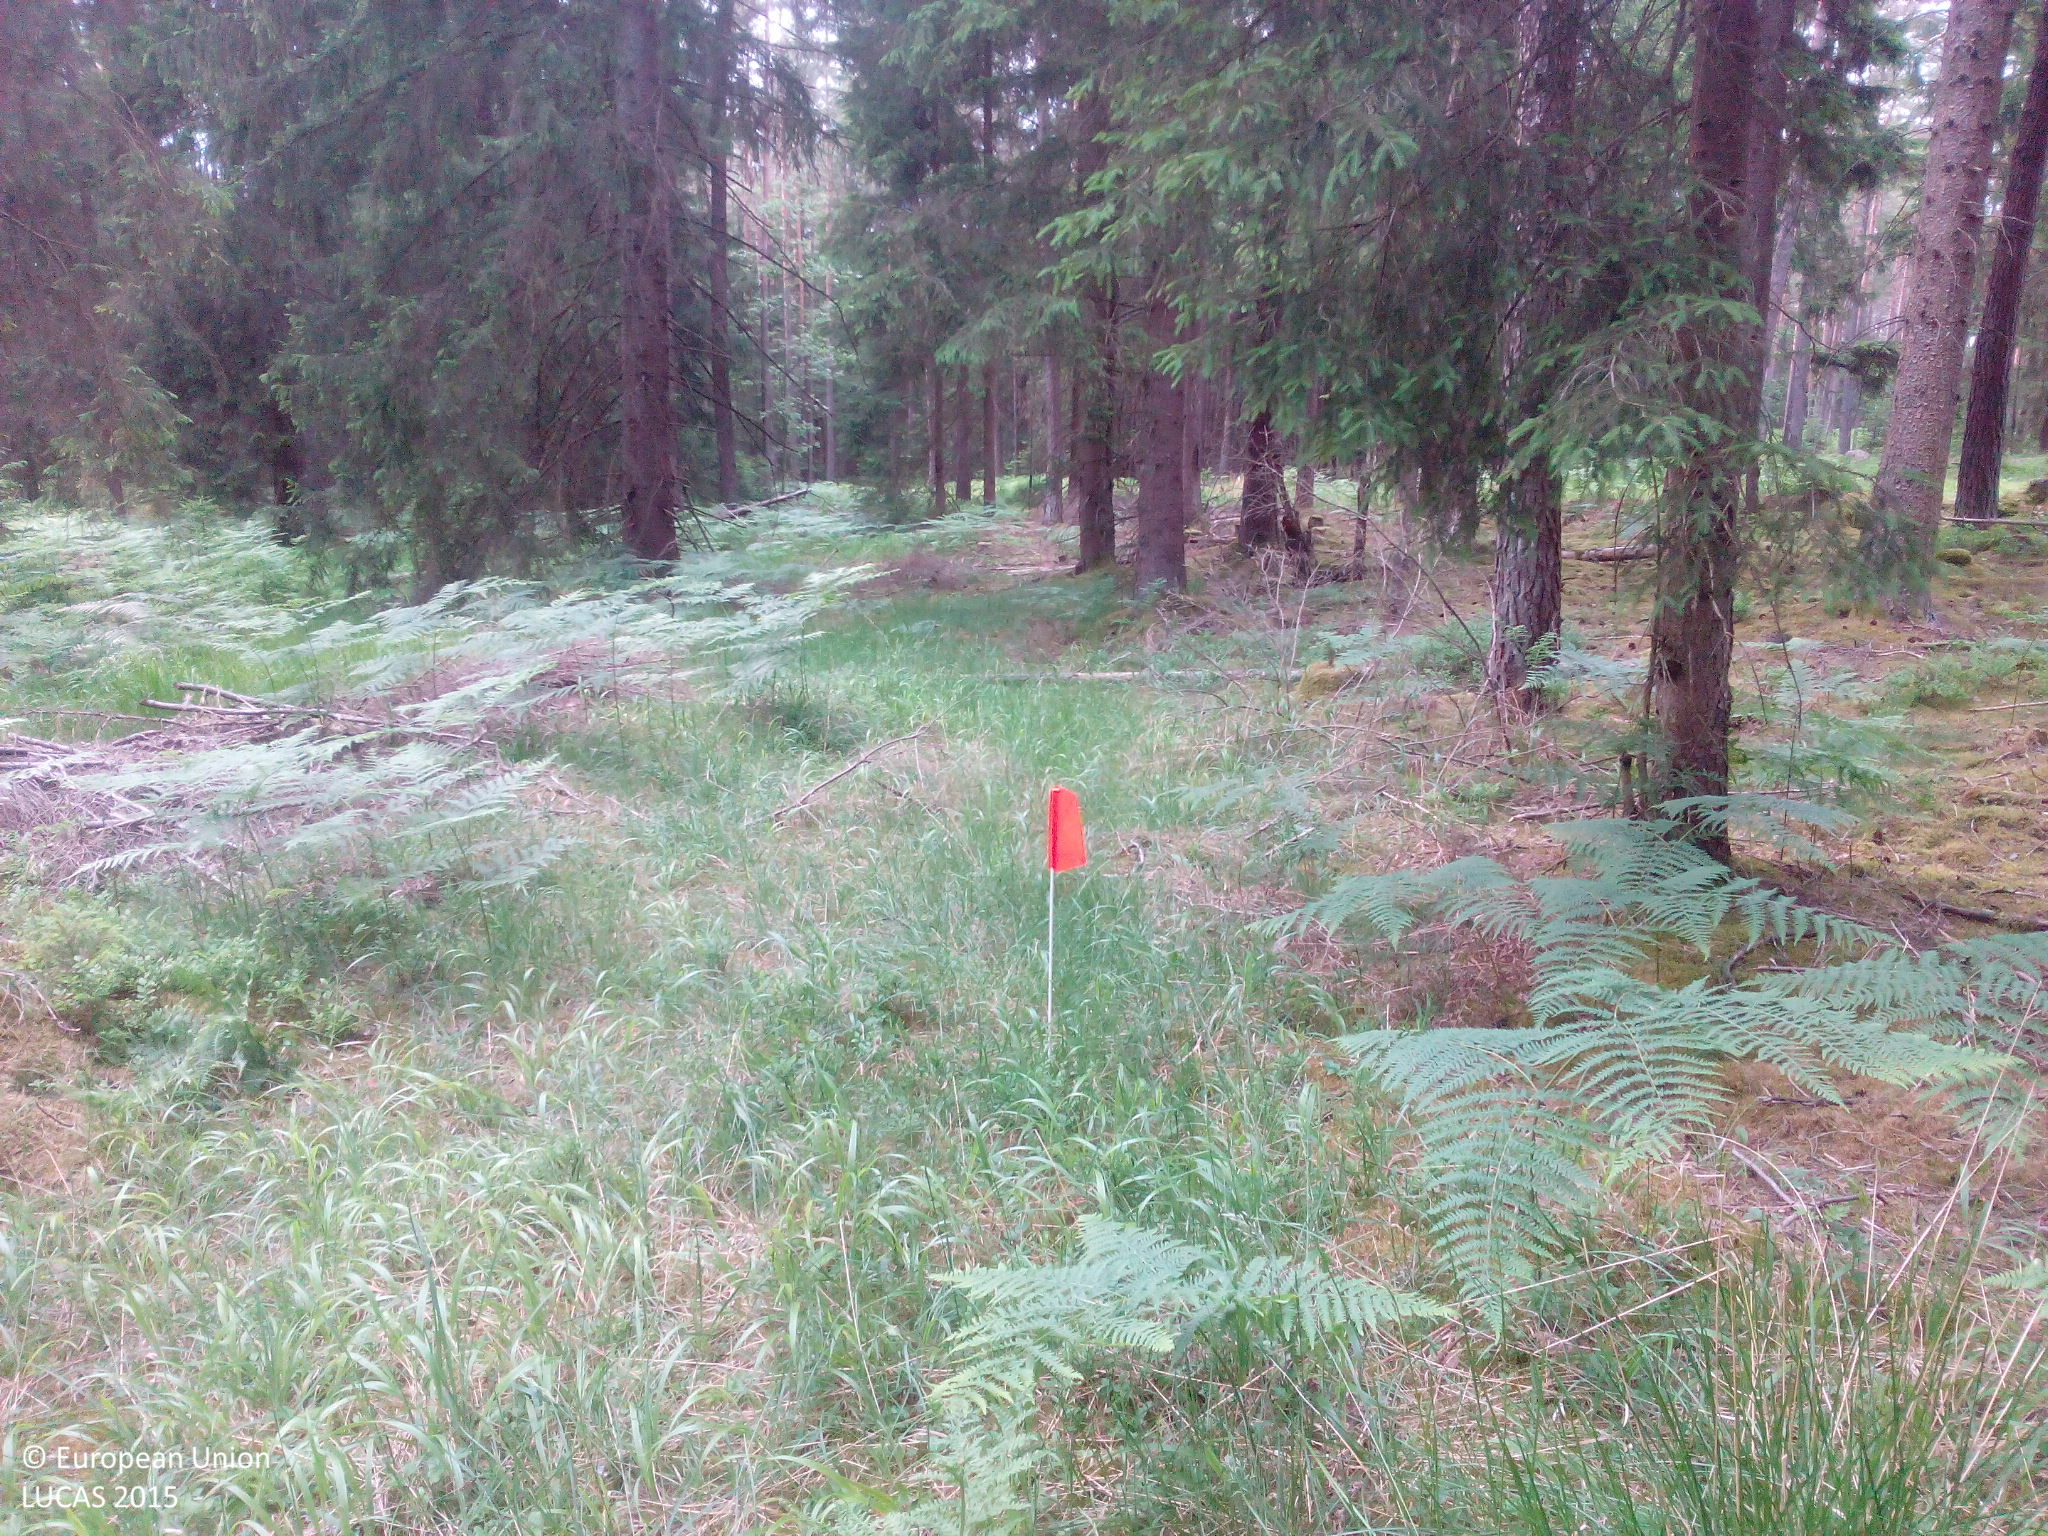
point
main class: Woodland
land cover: Other coniferous woodland
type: hemiboreal forest and nemoral coniferous forest and mixed broadleaved-coniferous forest
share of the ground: 50 - 75 %
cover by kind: coniferous forest trees 70 %, herbaceous plants 25 %, lichens and mosses 5 %
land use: Forestry
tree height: > 5 m
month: June
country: DE
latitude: 49.7069
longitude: 11.4833
